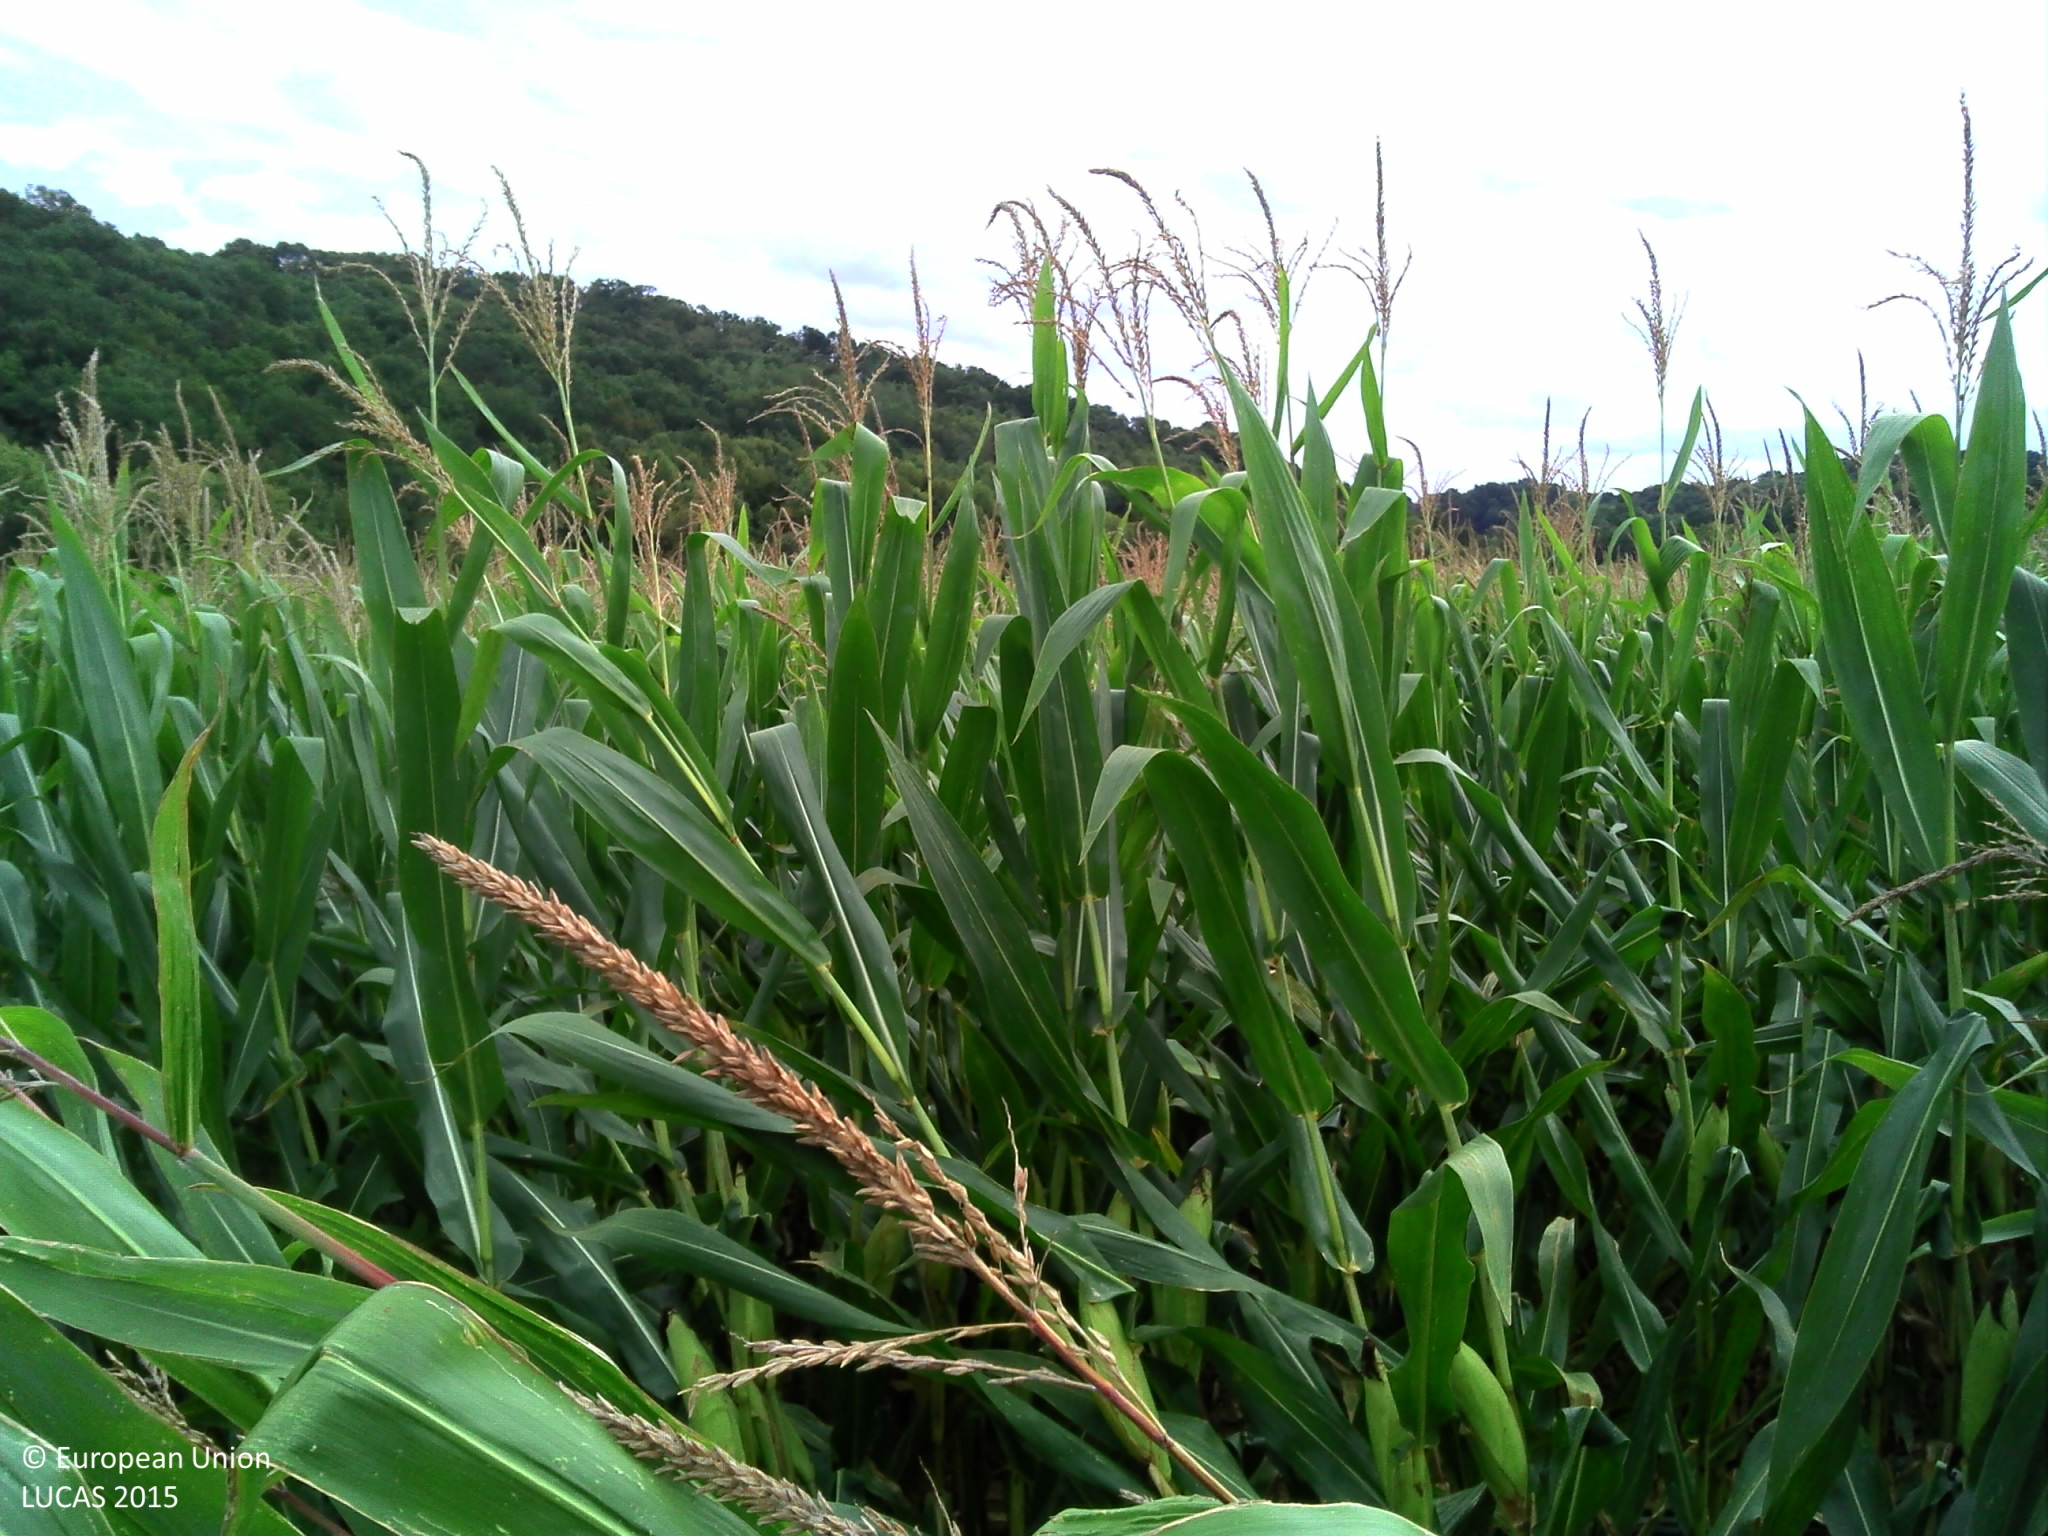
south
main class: Cropland
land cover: Maize
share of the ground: > 75 %
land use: Agriculture (excluding fallow land and kitchen gardens)
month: September
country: FR
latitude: 43.4850
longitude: -0.1825
